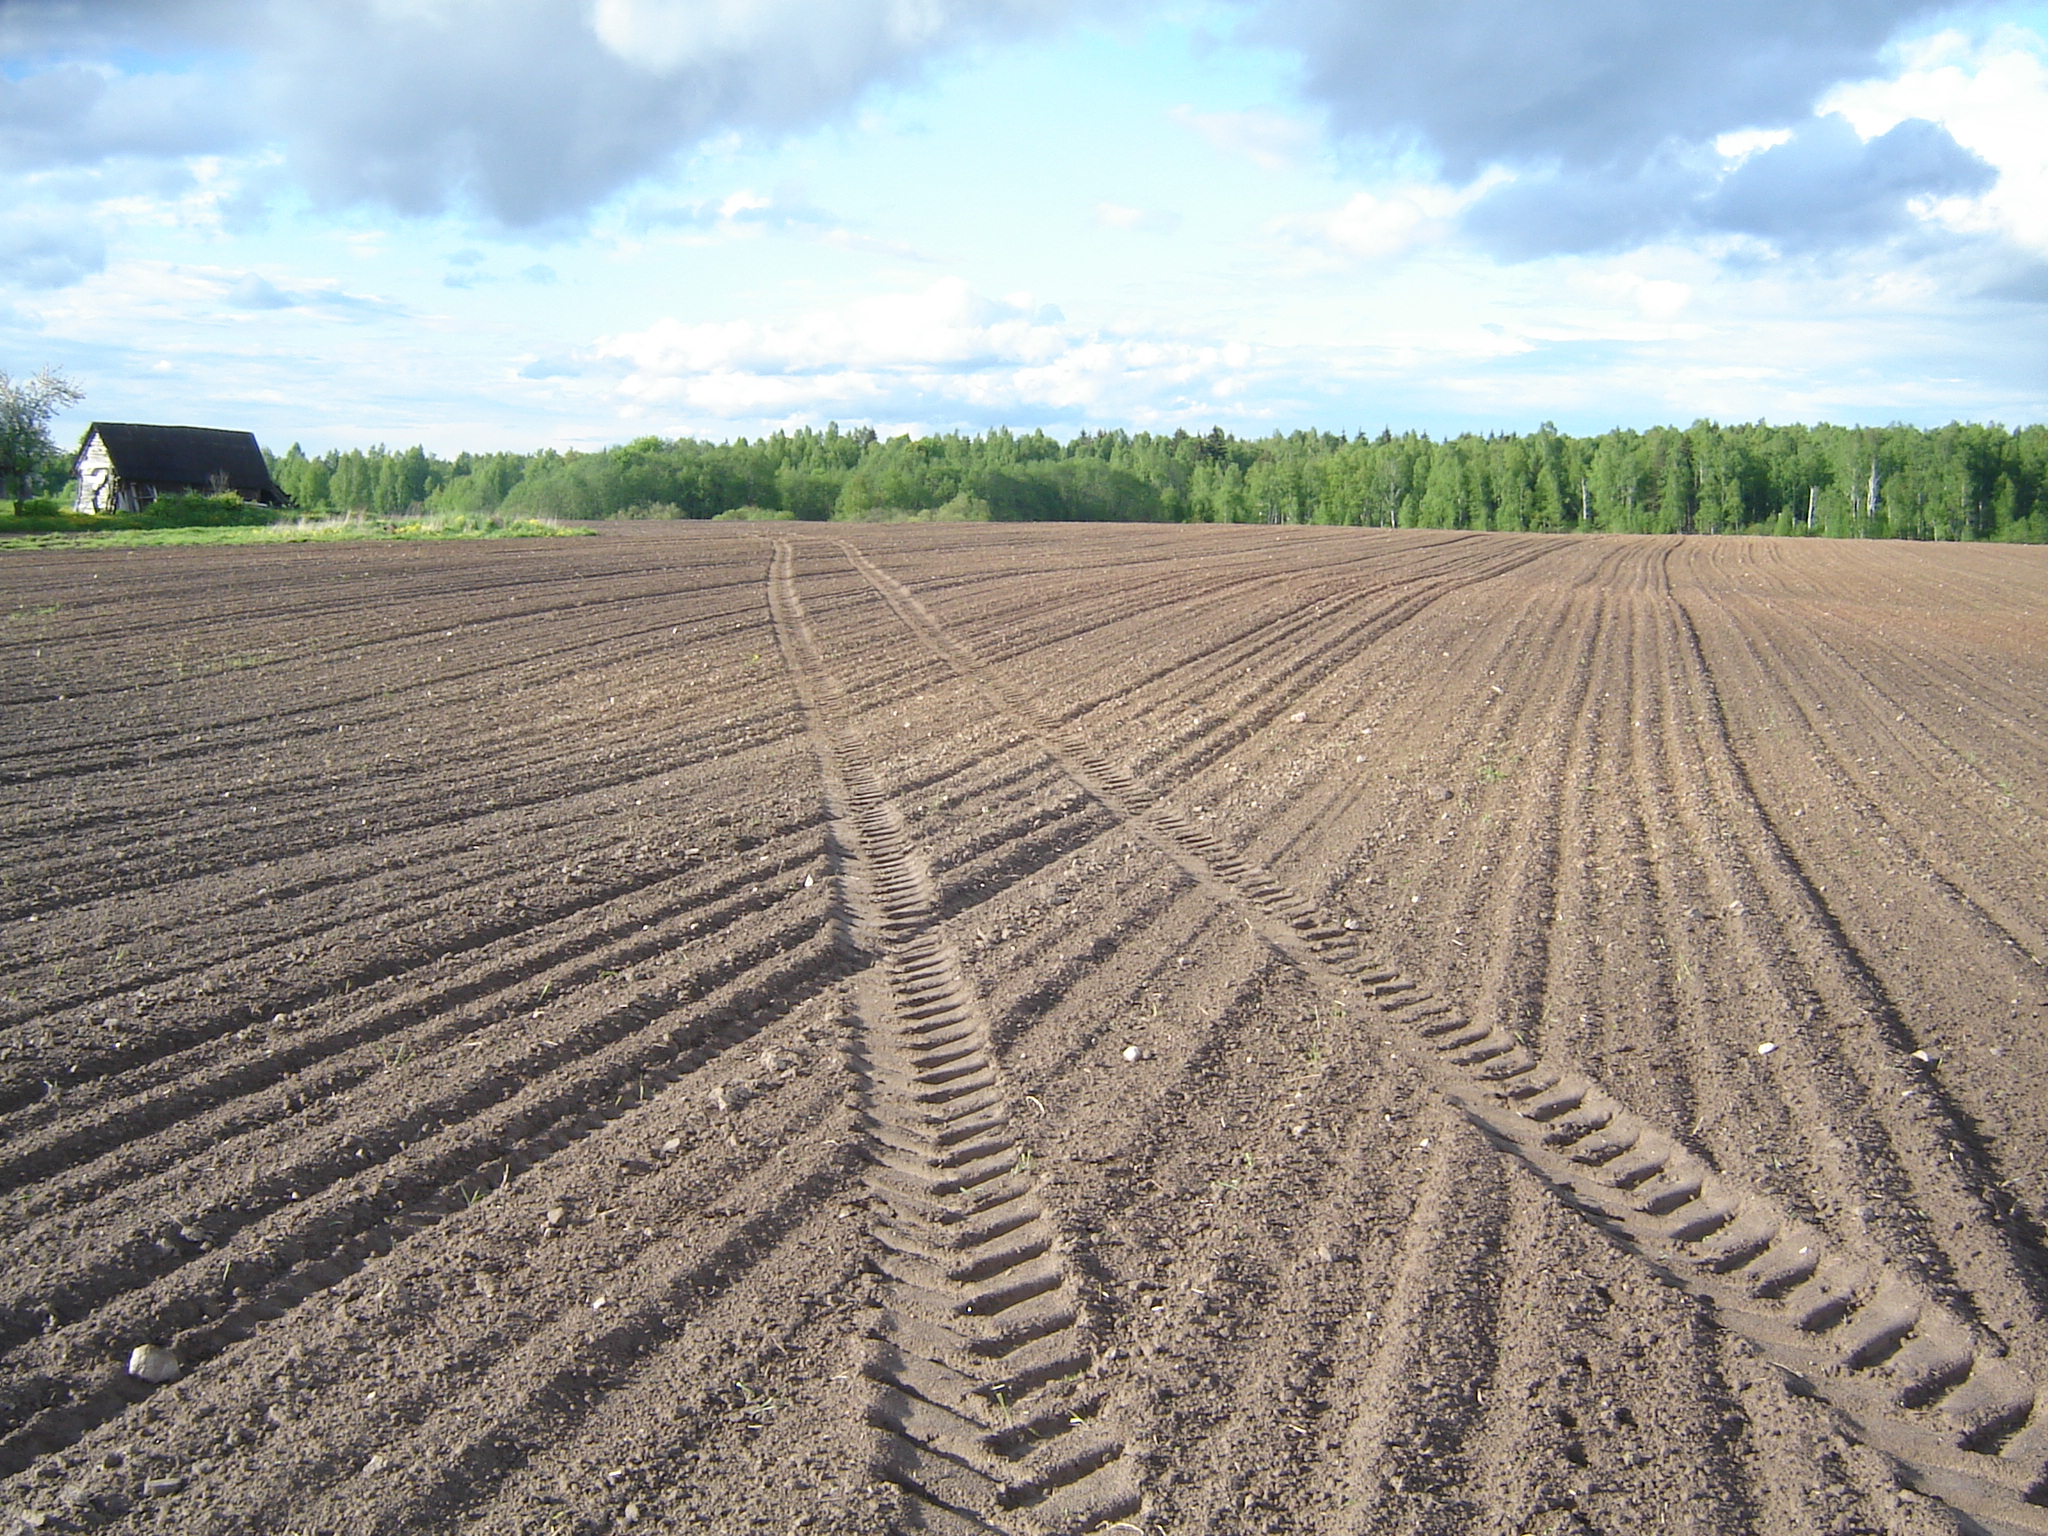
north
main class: Cropland
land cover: Oats
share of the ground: < 10 %
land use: Agriculture (excluding fallow land and kitchen gardens)
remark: Tilled/Sowed
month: May
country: LT
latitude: 56.0658
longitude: 25.3285
